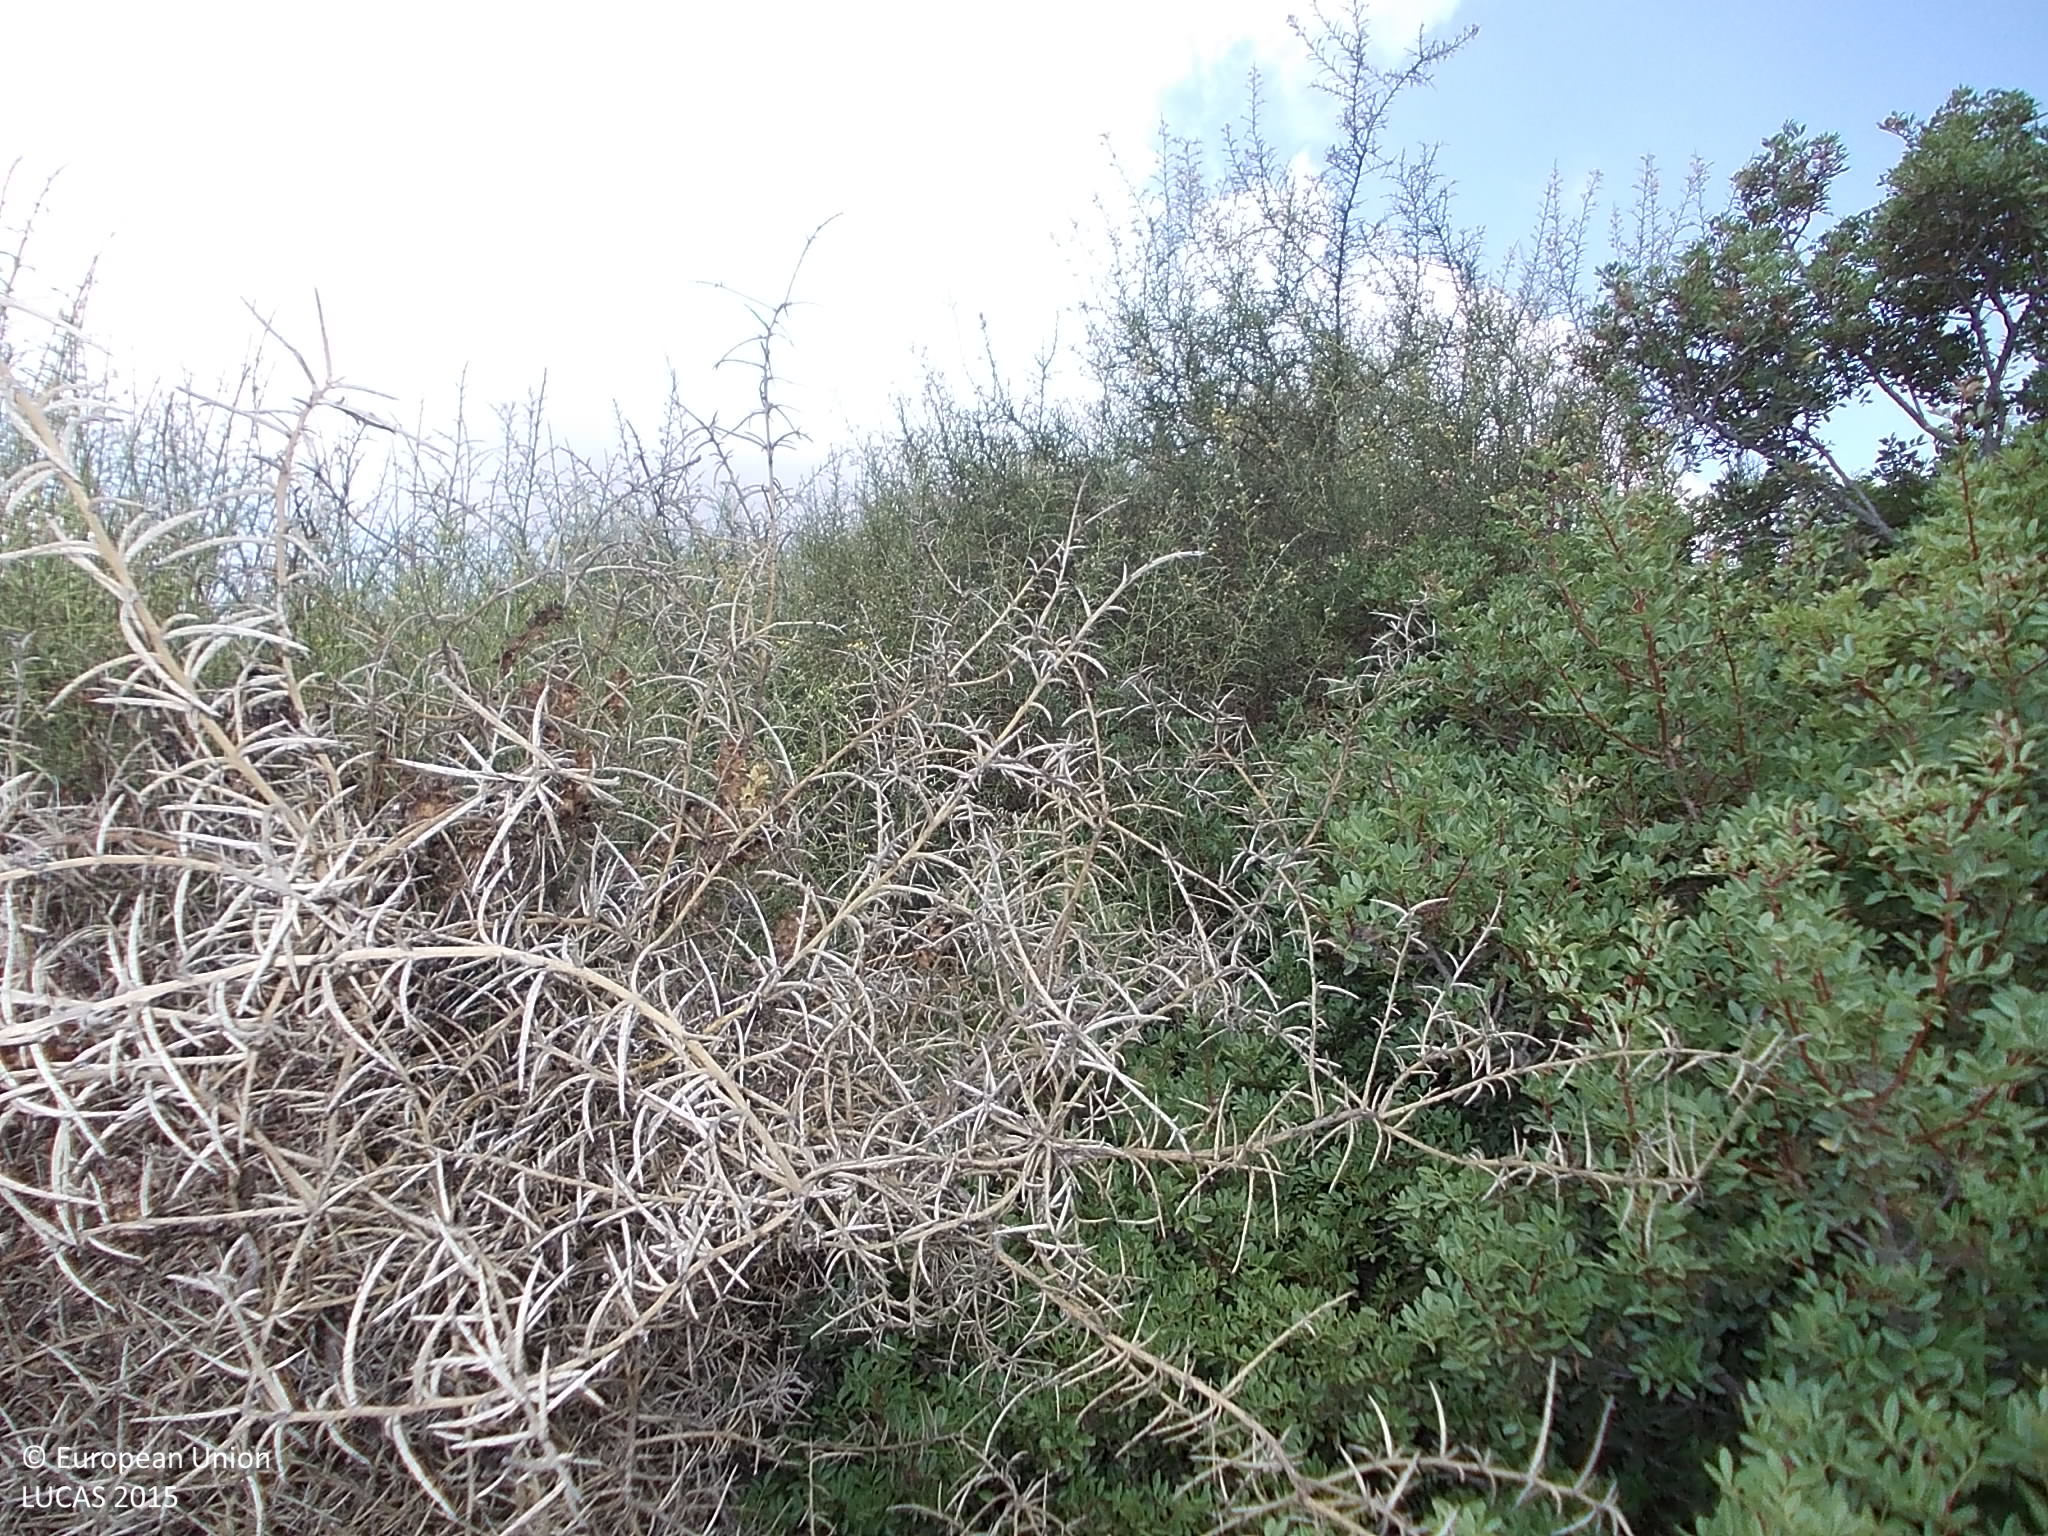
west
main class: Shrubland
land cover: Shrubland with sparse tree cover
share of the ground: > 75 %
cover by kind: shrubs 85 %, broadleaved forest trees 5 %, herbaceous plants 5 %, unconsolidated bare surface 5 %
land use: Semi-natural and natural areas not in use
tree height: < 5 m
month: August
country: CY
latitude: 34.7023
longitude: 32.6967
